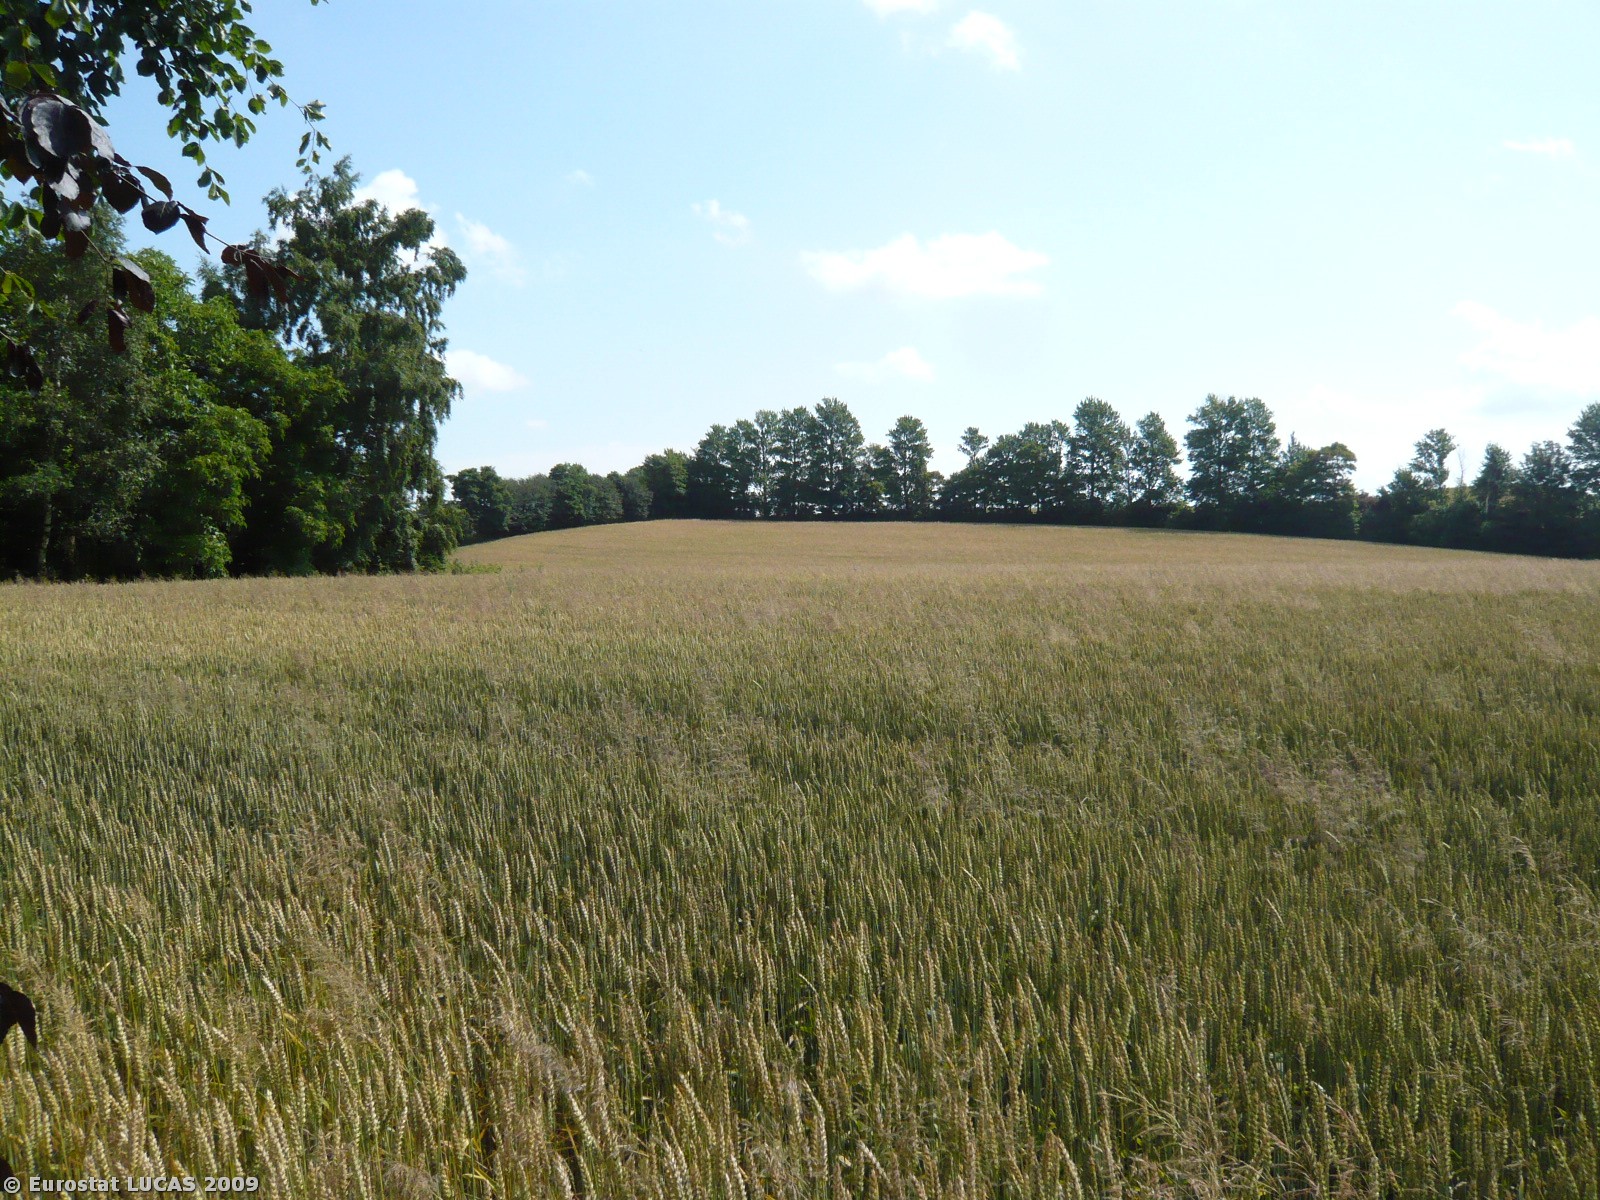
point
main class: Woodland
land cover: Broadleaved woodland
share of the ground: > 75 %
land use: Unused
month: July
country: DK
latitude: 55.8013
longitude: 11.5140
